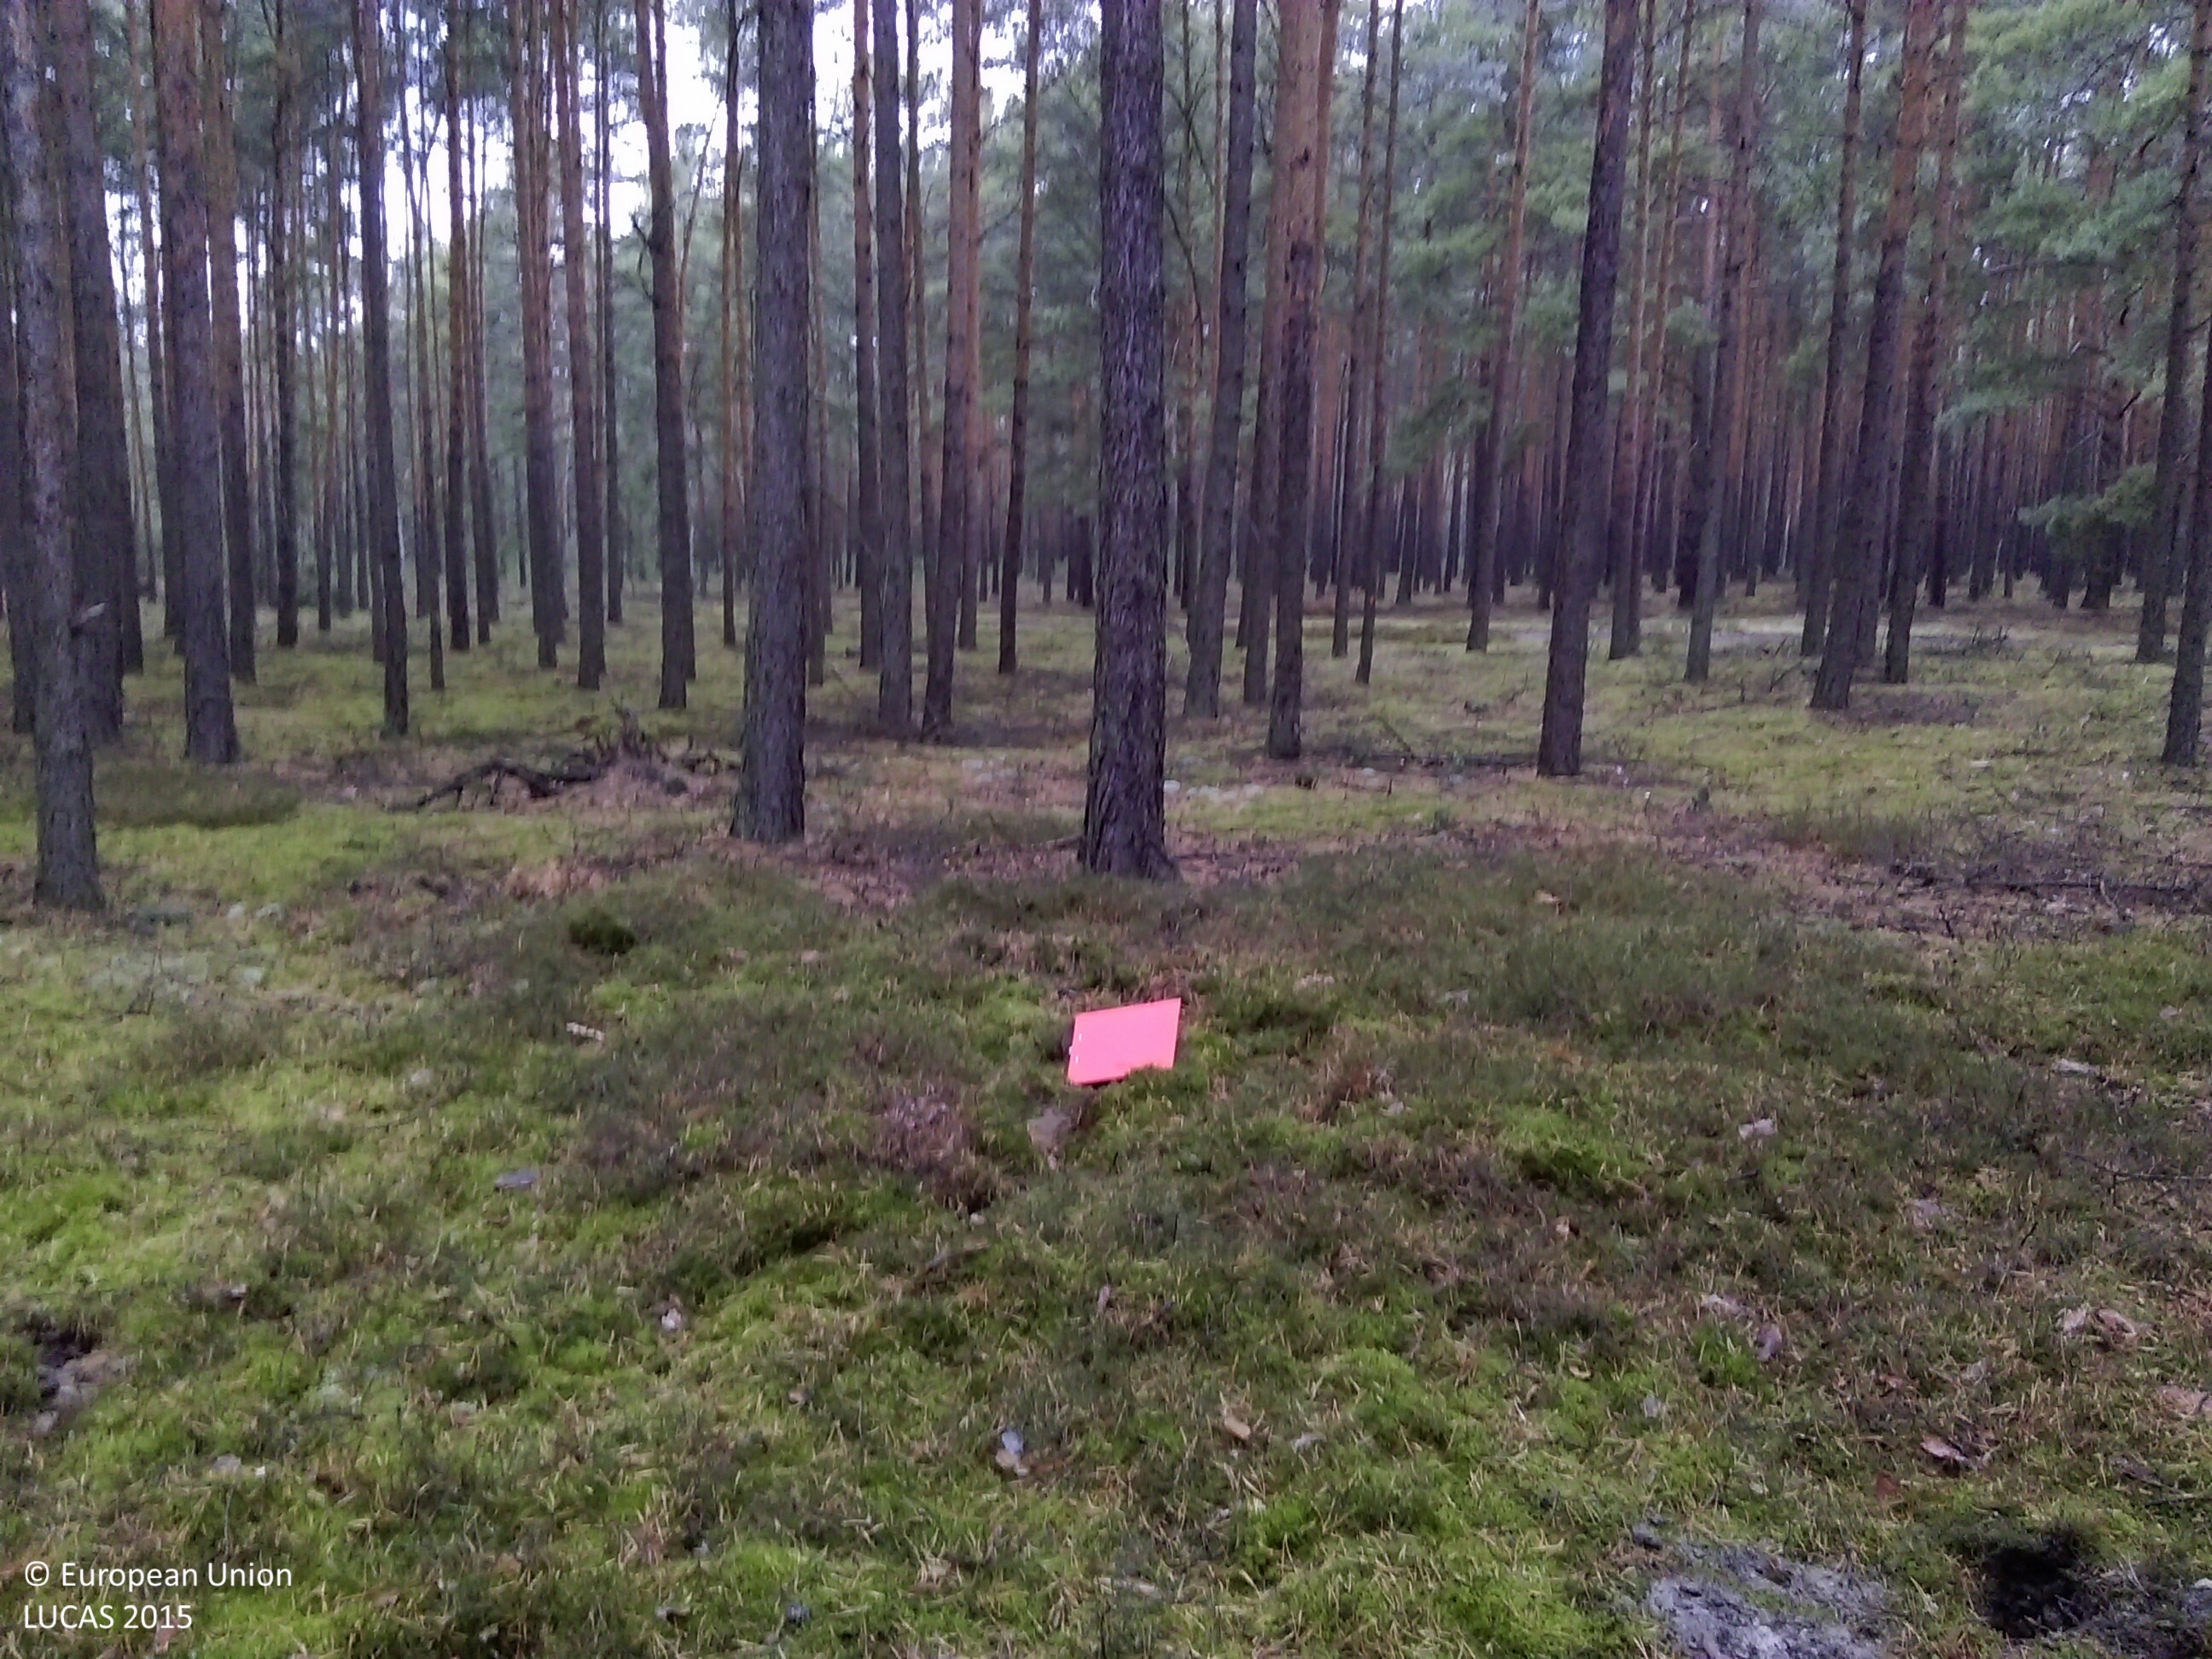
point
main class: Woodland
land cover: Pine dominated coniferous woodland
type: hemiboreal forest and nemoral coniferous forest and mixed broadleaved-coniferous forest
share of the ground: > 75 %
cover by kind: coniferous forest trees 85 %, lichens and mosses 15 %
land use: Forestry
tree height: > 5 m
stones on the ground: < 10 %
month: November
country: PL
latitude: 51.9581
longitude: 15.5778
